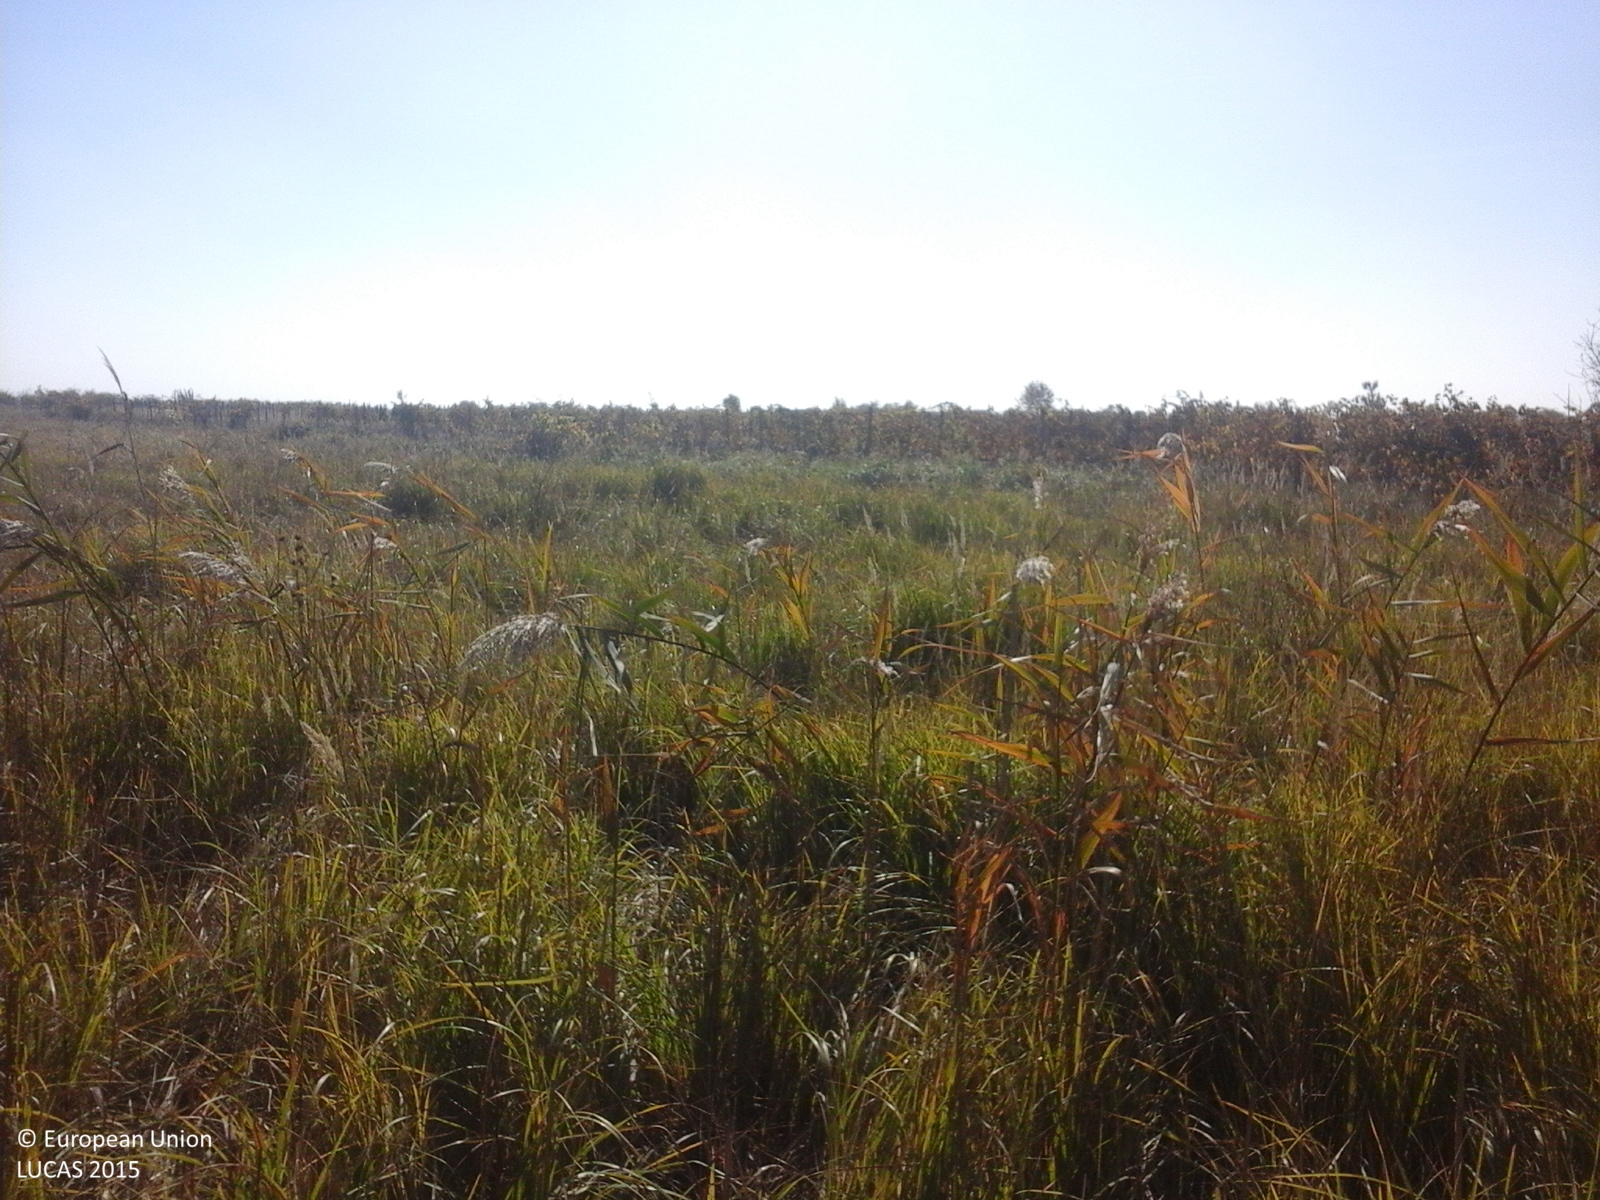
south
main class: Grassland
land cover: Spontaneously vegetated surfaces
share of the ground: > 75 %
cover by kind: herbaceous plants 100 %
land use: Fallow land
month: October
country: RO
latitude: 45.1062
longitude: 26.6609
